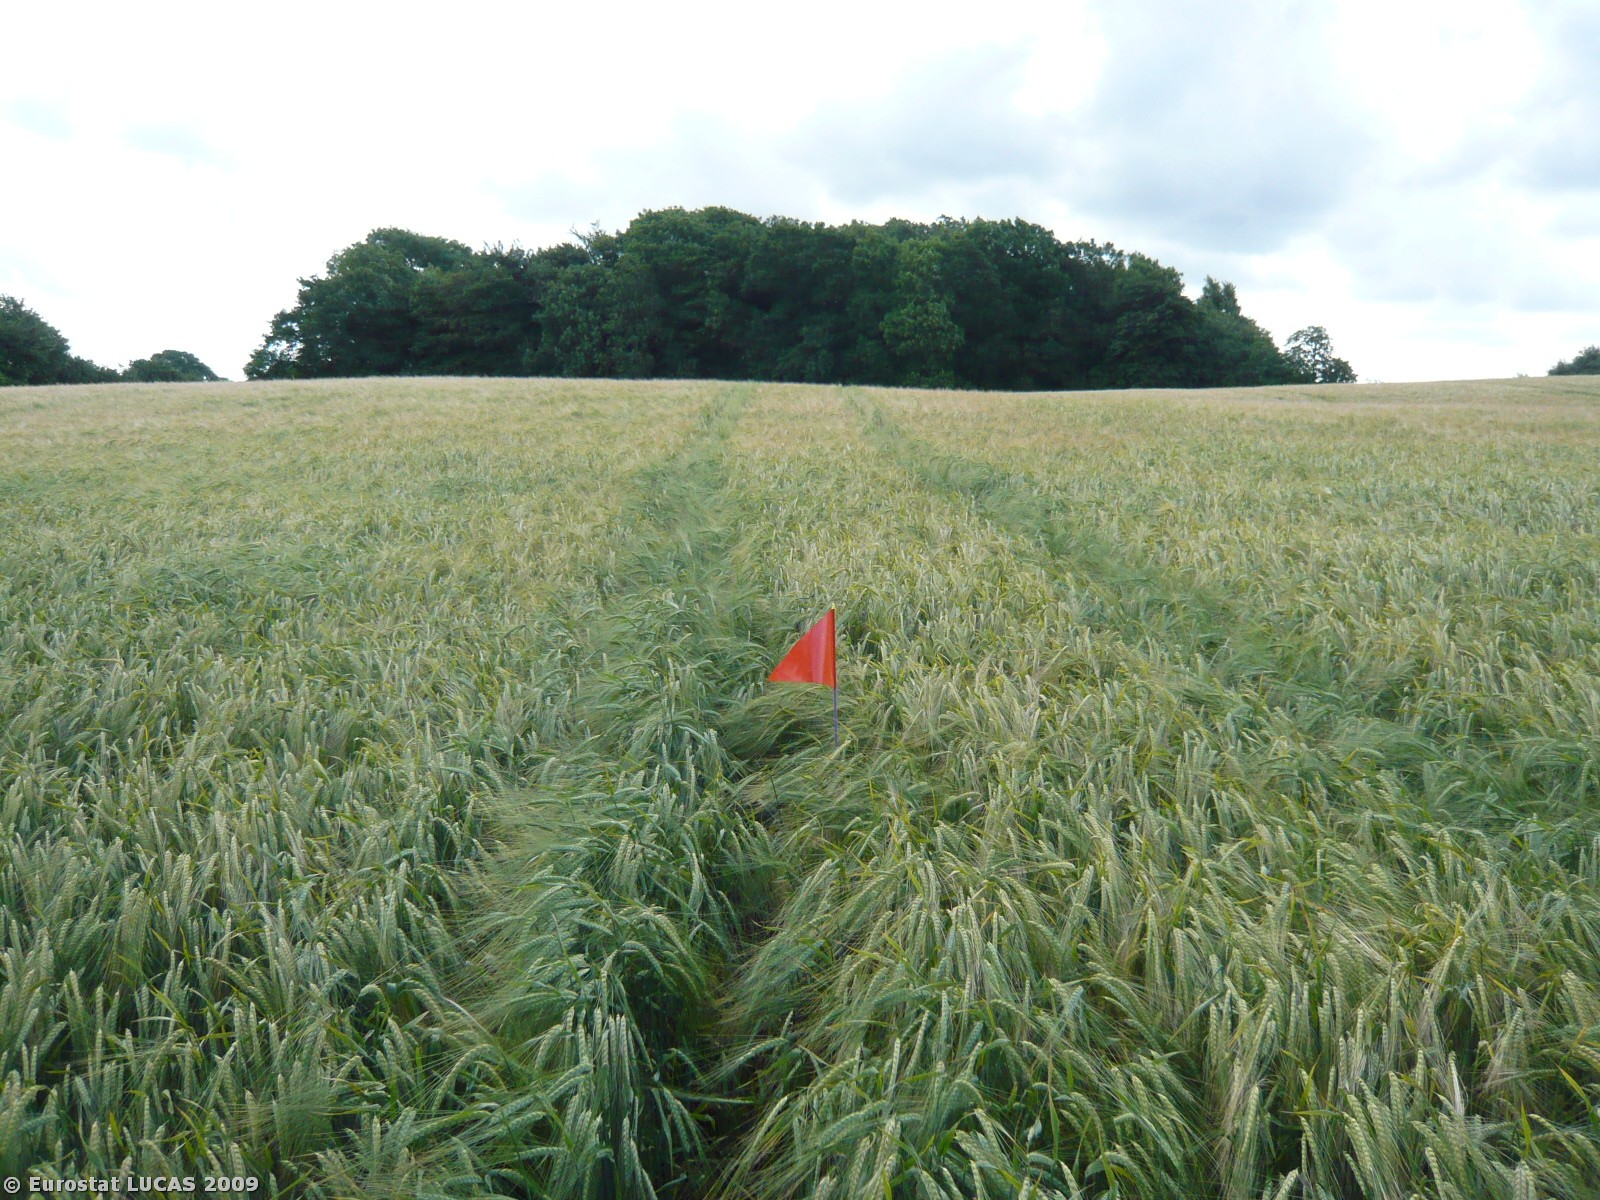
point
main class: Cropland
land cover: Barley
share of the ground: > 75 %
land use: Agriculture (excluding fallow land and kitchen gardens)
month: July
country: DK
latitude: 55.4687
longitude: 10.1422
